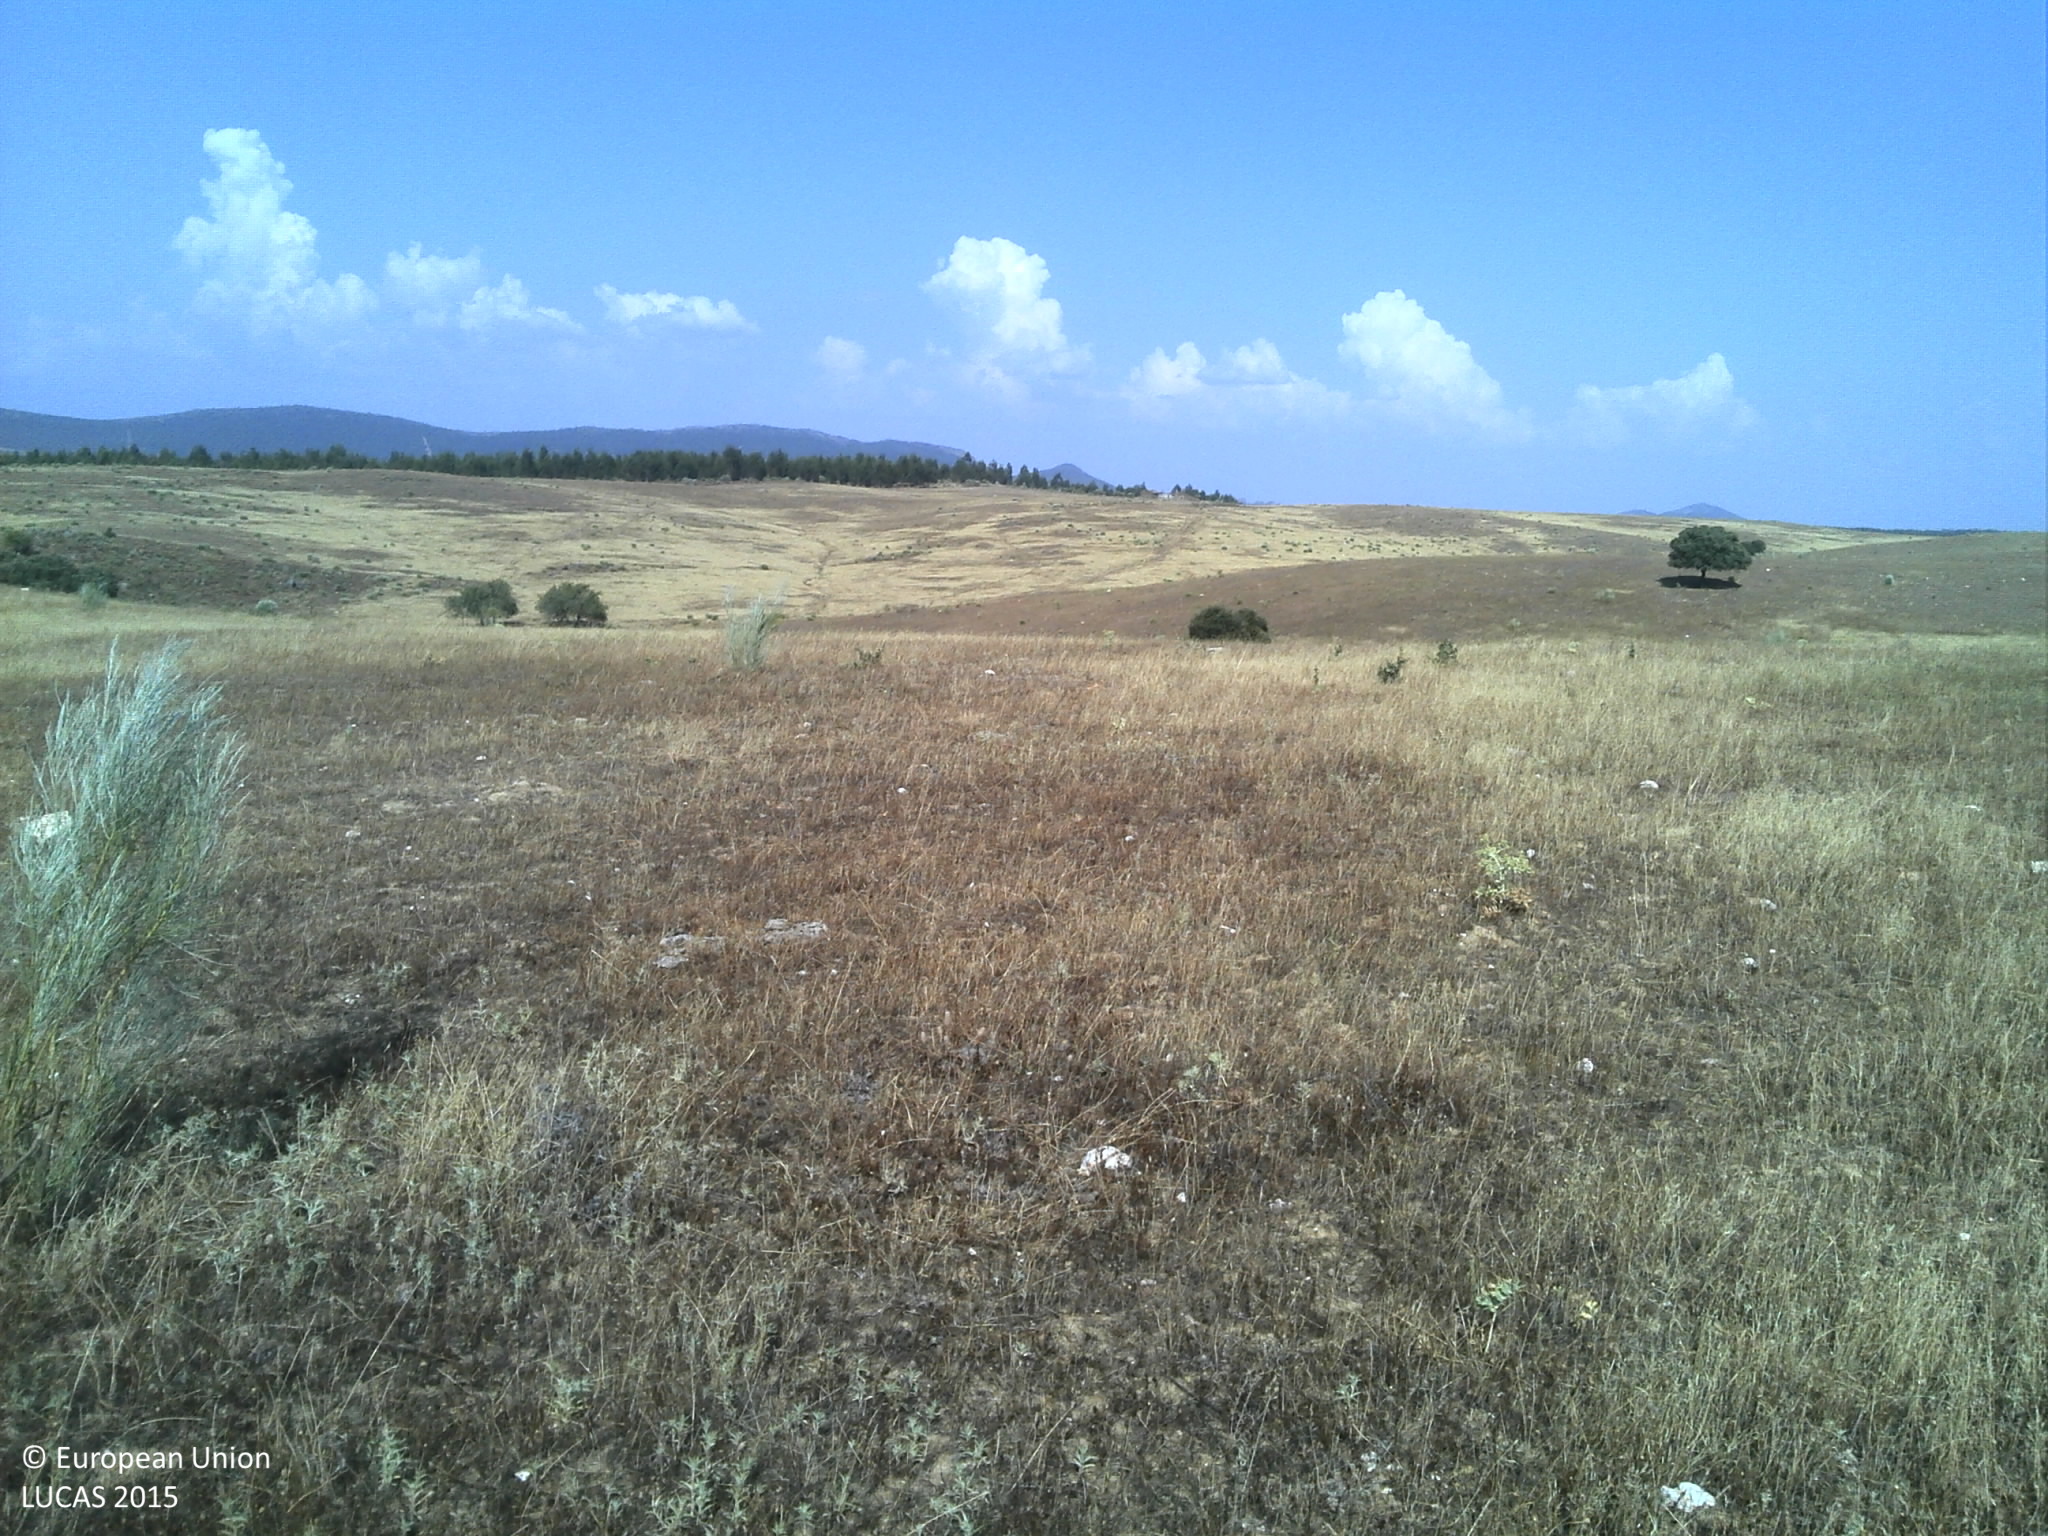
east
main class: Grassland
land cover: Grassland without tree/shrub cover
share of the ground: 25 - 50 %
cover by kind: unconsolidated bare surface 55 %, herbaceous plants 35 %, shrubs 5 %
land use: Agriculture (excluding fallow land and kitchen gardens)
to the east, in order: Grassland without tree/shrub cover; Rivers and streams; Grassland without tree/shrub cover
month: June
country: PT
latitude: 39.9494
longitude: -6.9071
